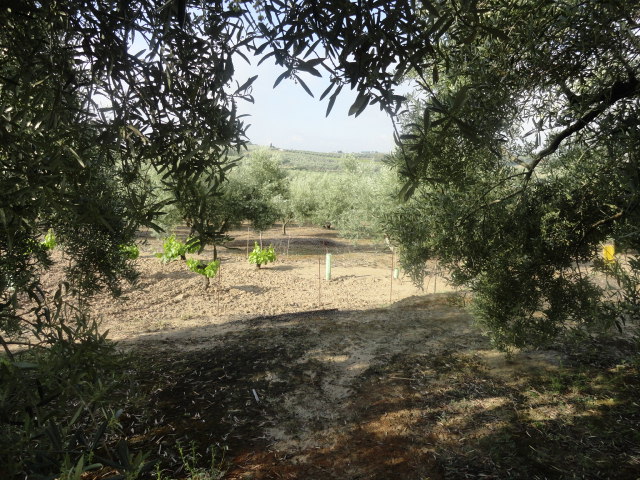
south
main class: Cropland
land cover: Olive groves
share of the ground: > 75 %
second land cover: Spontaneously vegetated surfaces
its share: 10 - 25 %
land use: Agriculture (excluding fallow land and kitchen gardens)
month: April
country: ES
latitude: 37.5881
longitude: -4.6048
